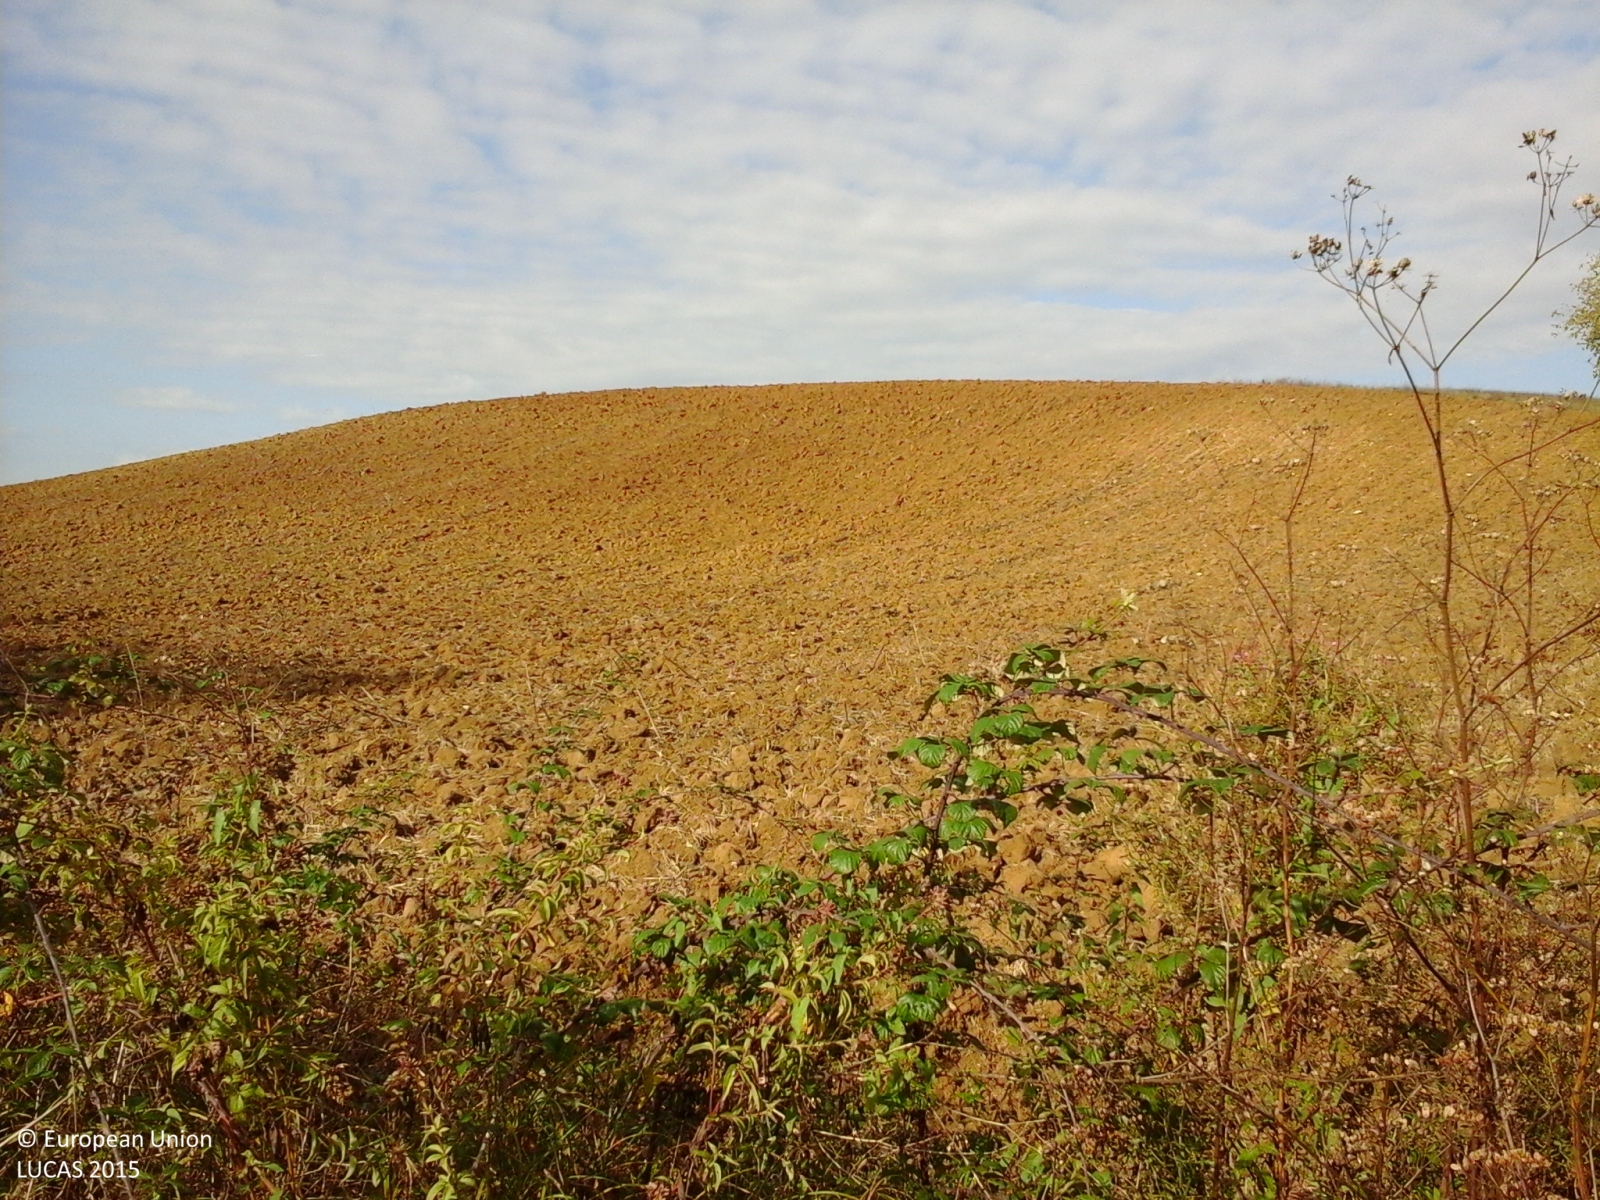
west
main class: Cropland
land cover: Lucerne
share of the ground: > 75 %
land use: Agriculture (excluding fallow land and kitchen gardens)
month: October
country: IT
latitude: 43.2880
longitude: 12.6425
